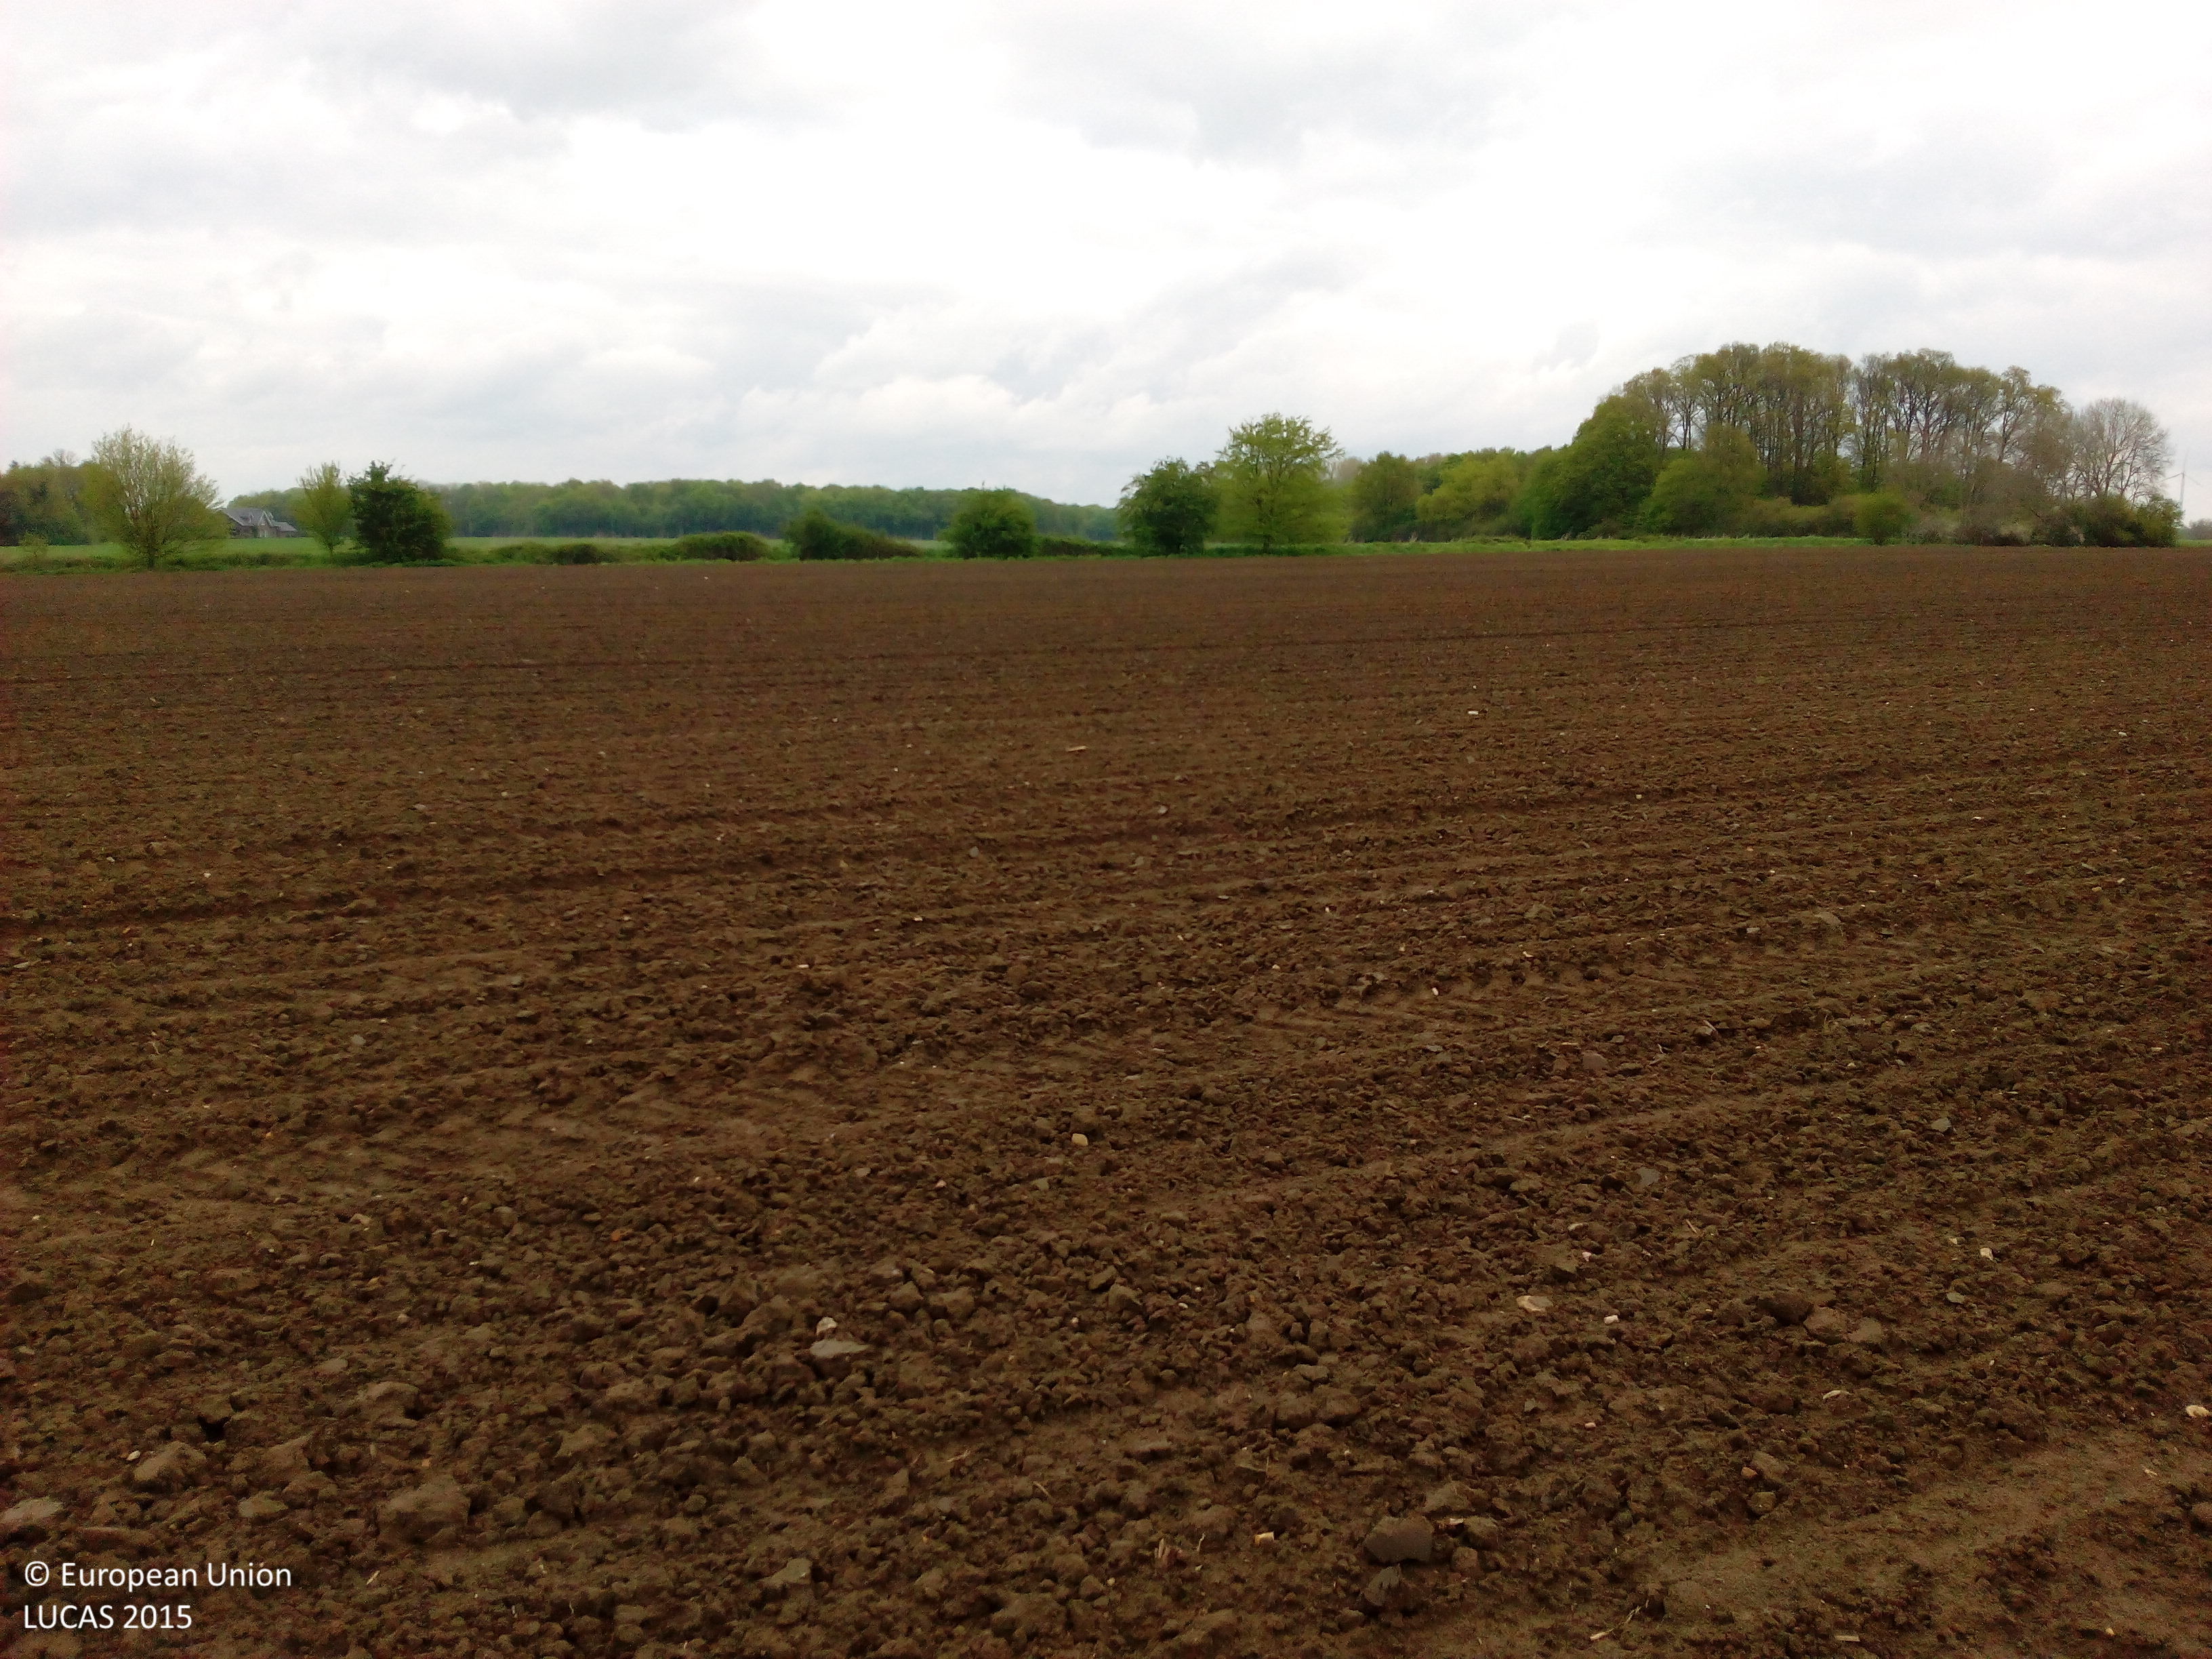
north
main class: Cropland
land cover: Maize
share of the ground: < 10 %
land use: Agriculture (excluding fallow land and kitchen gardens)
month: May
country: DE
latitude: 52.0790
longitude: 7.3884
